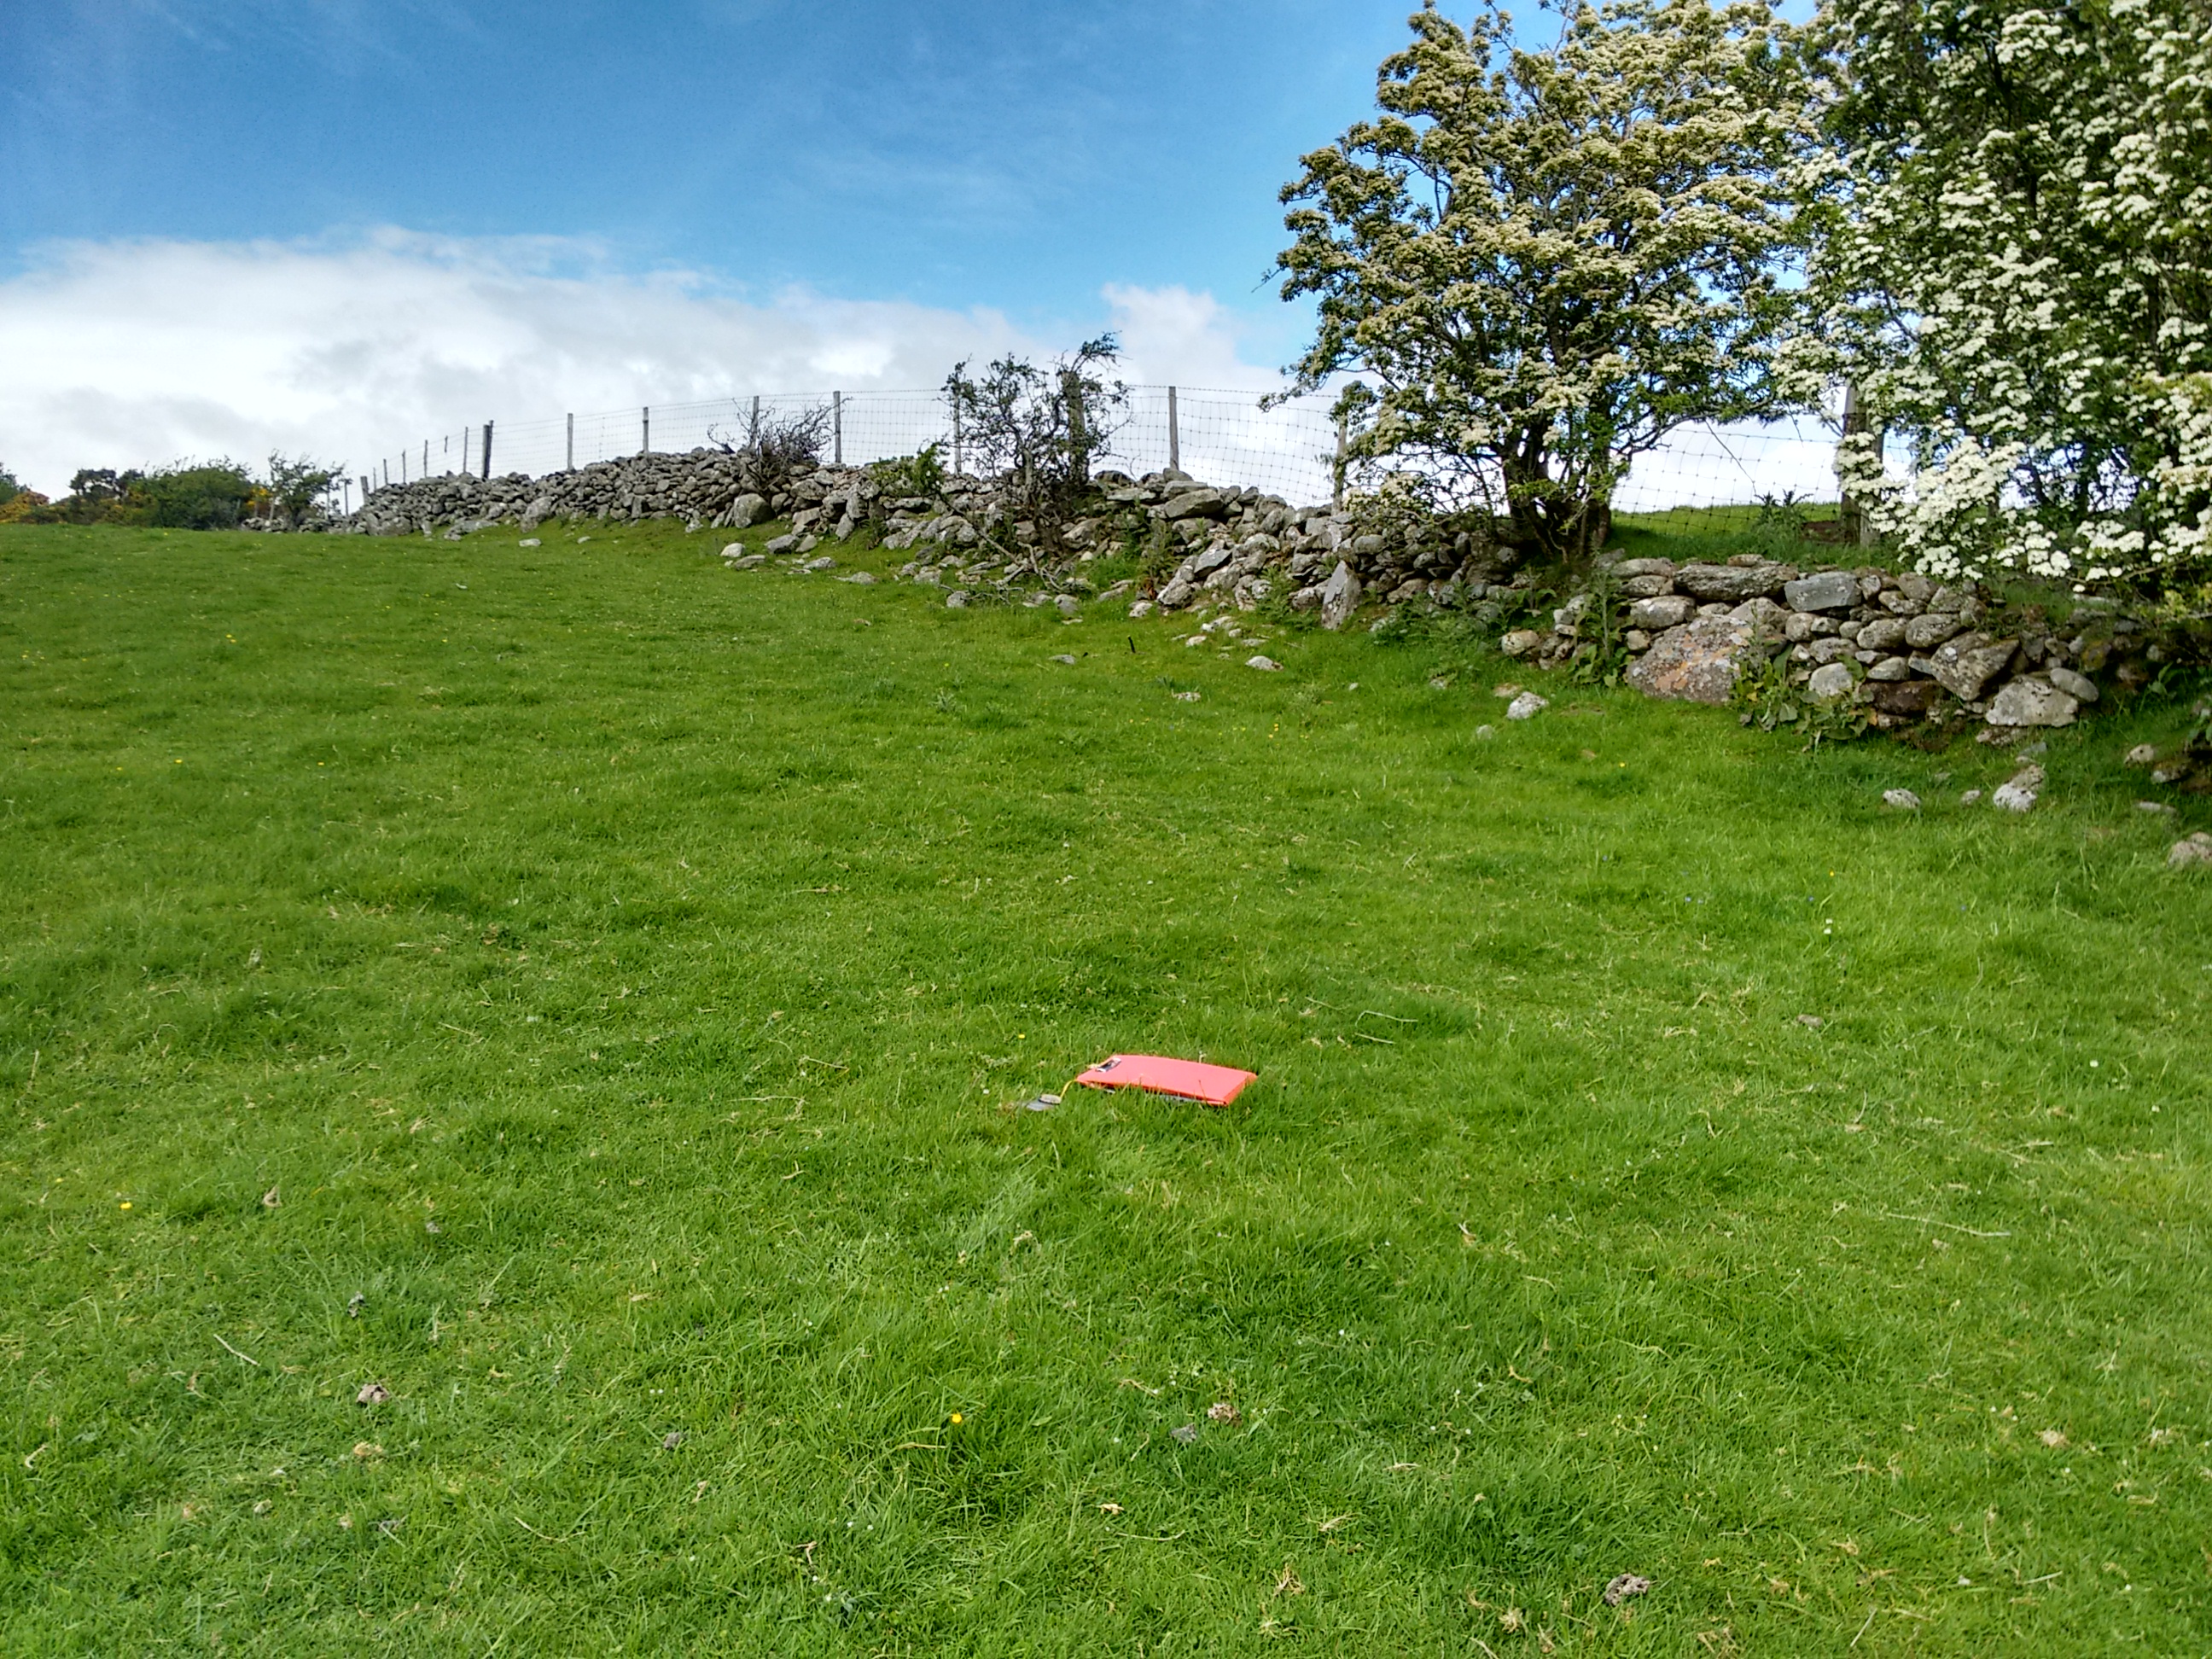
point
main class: Grassland
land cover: Grassland without tree/shrub cover
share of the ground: > 75 %
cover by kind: herbaceous plants 100 %
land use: Agriculture (excluding fallow land and kitchen gardens)
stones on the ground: 25 - 50 %
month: June
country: GB
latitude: 54.8724
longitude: -7.0158
